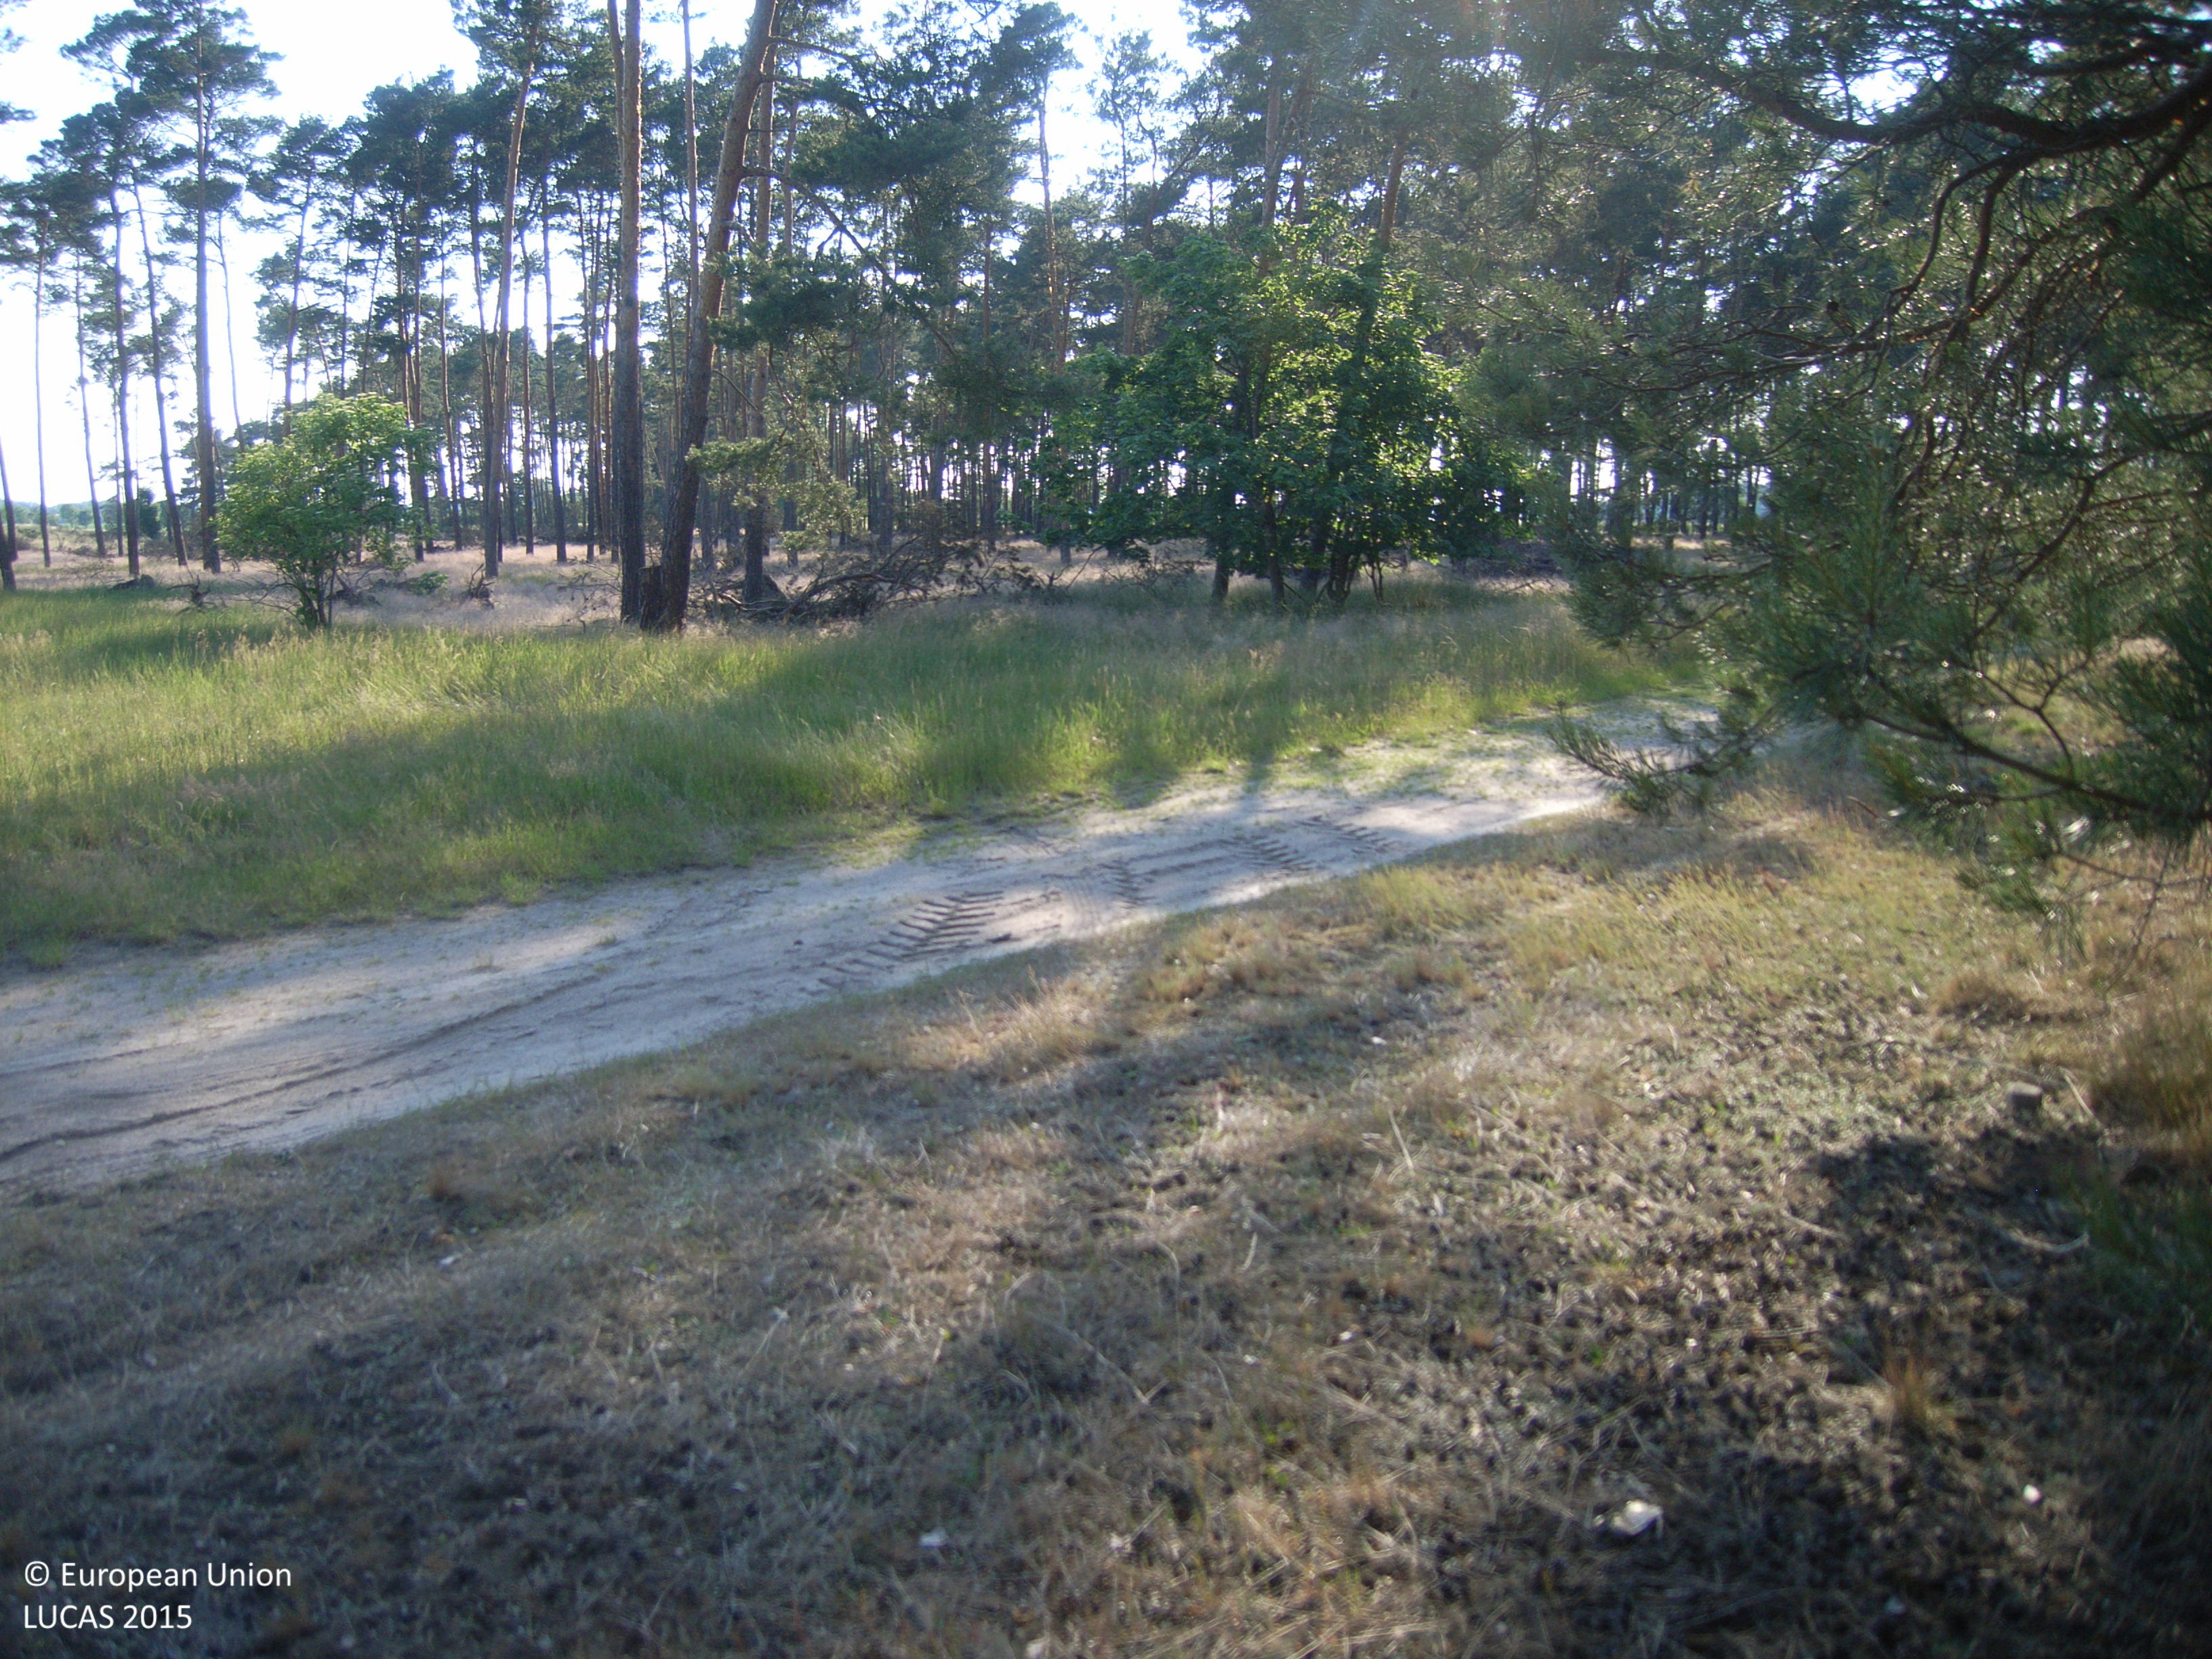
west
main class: Woodland
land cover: Pine dominated coniferous woodland
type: hemiboreal forest and nemoral coniferous forest and mixed broadleaved-coniferous forest
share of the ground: > 75 %
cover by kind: coniferous forest trees 100 %
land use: Forestry
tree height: > 5 m
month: June
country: DE
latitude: 52.0368
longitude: 14.0974
